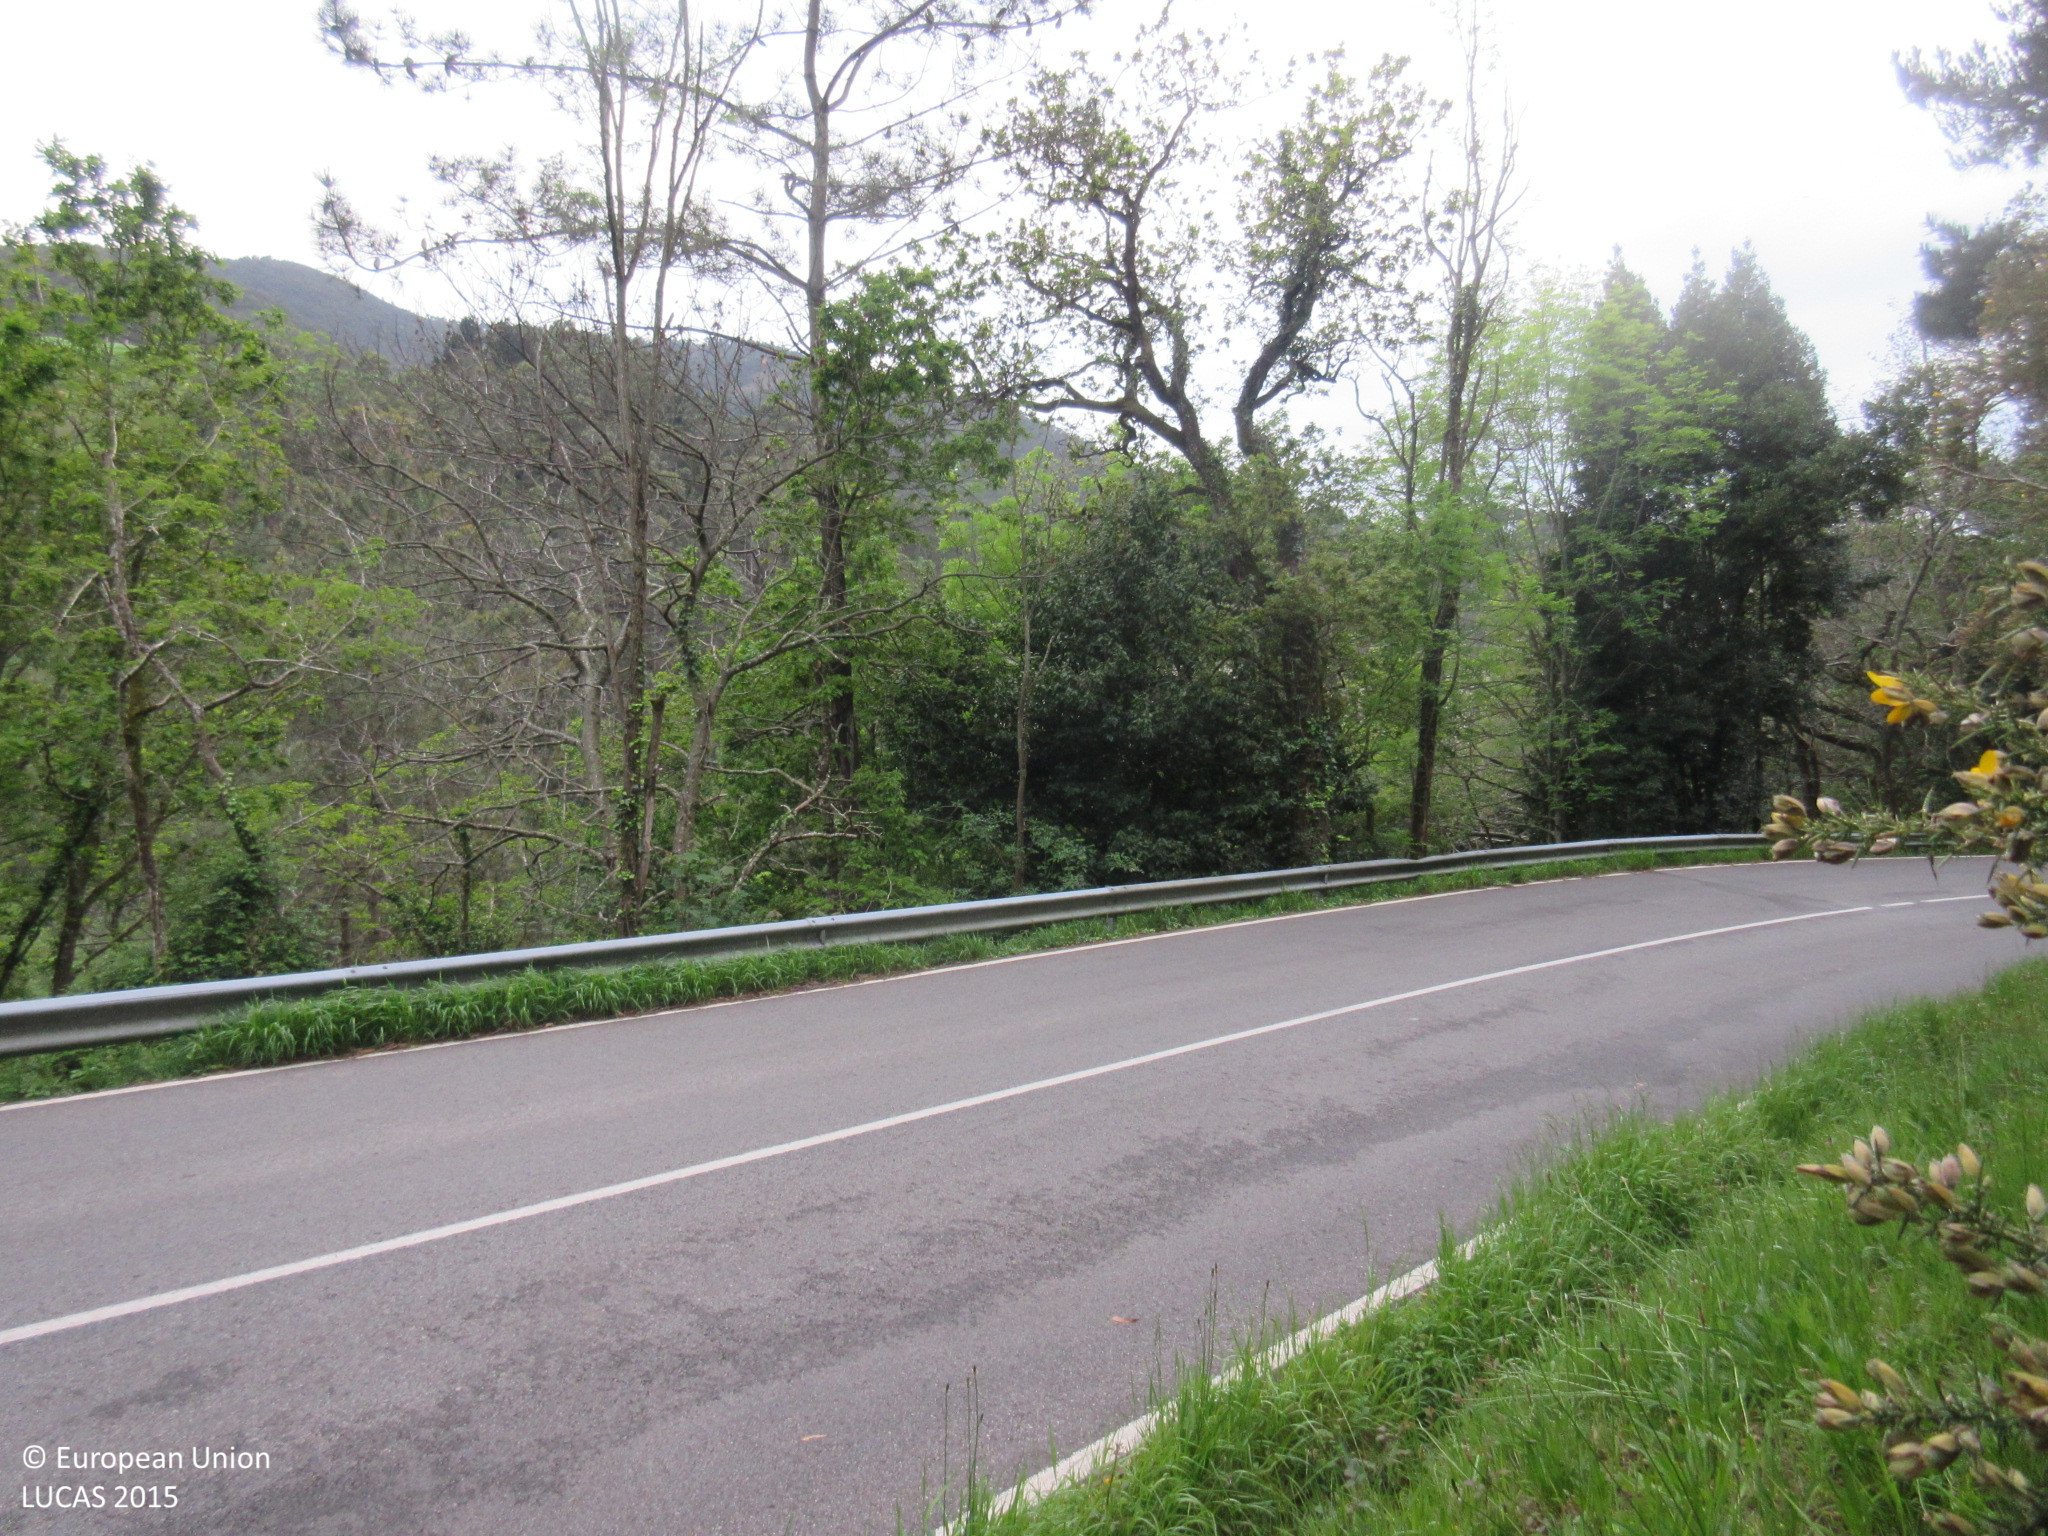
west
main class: Shrubland
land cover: Shrubland with sparse tree cover
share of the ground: > 75 %
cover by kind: shrubs 95 %, coniferous forest trees 5 %
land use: Forestry
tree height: > 5 m
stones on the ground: 10 - 25 %
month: April
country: ES
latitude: 43.5410
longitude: -6.4524
